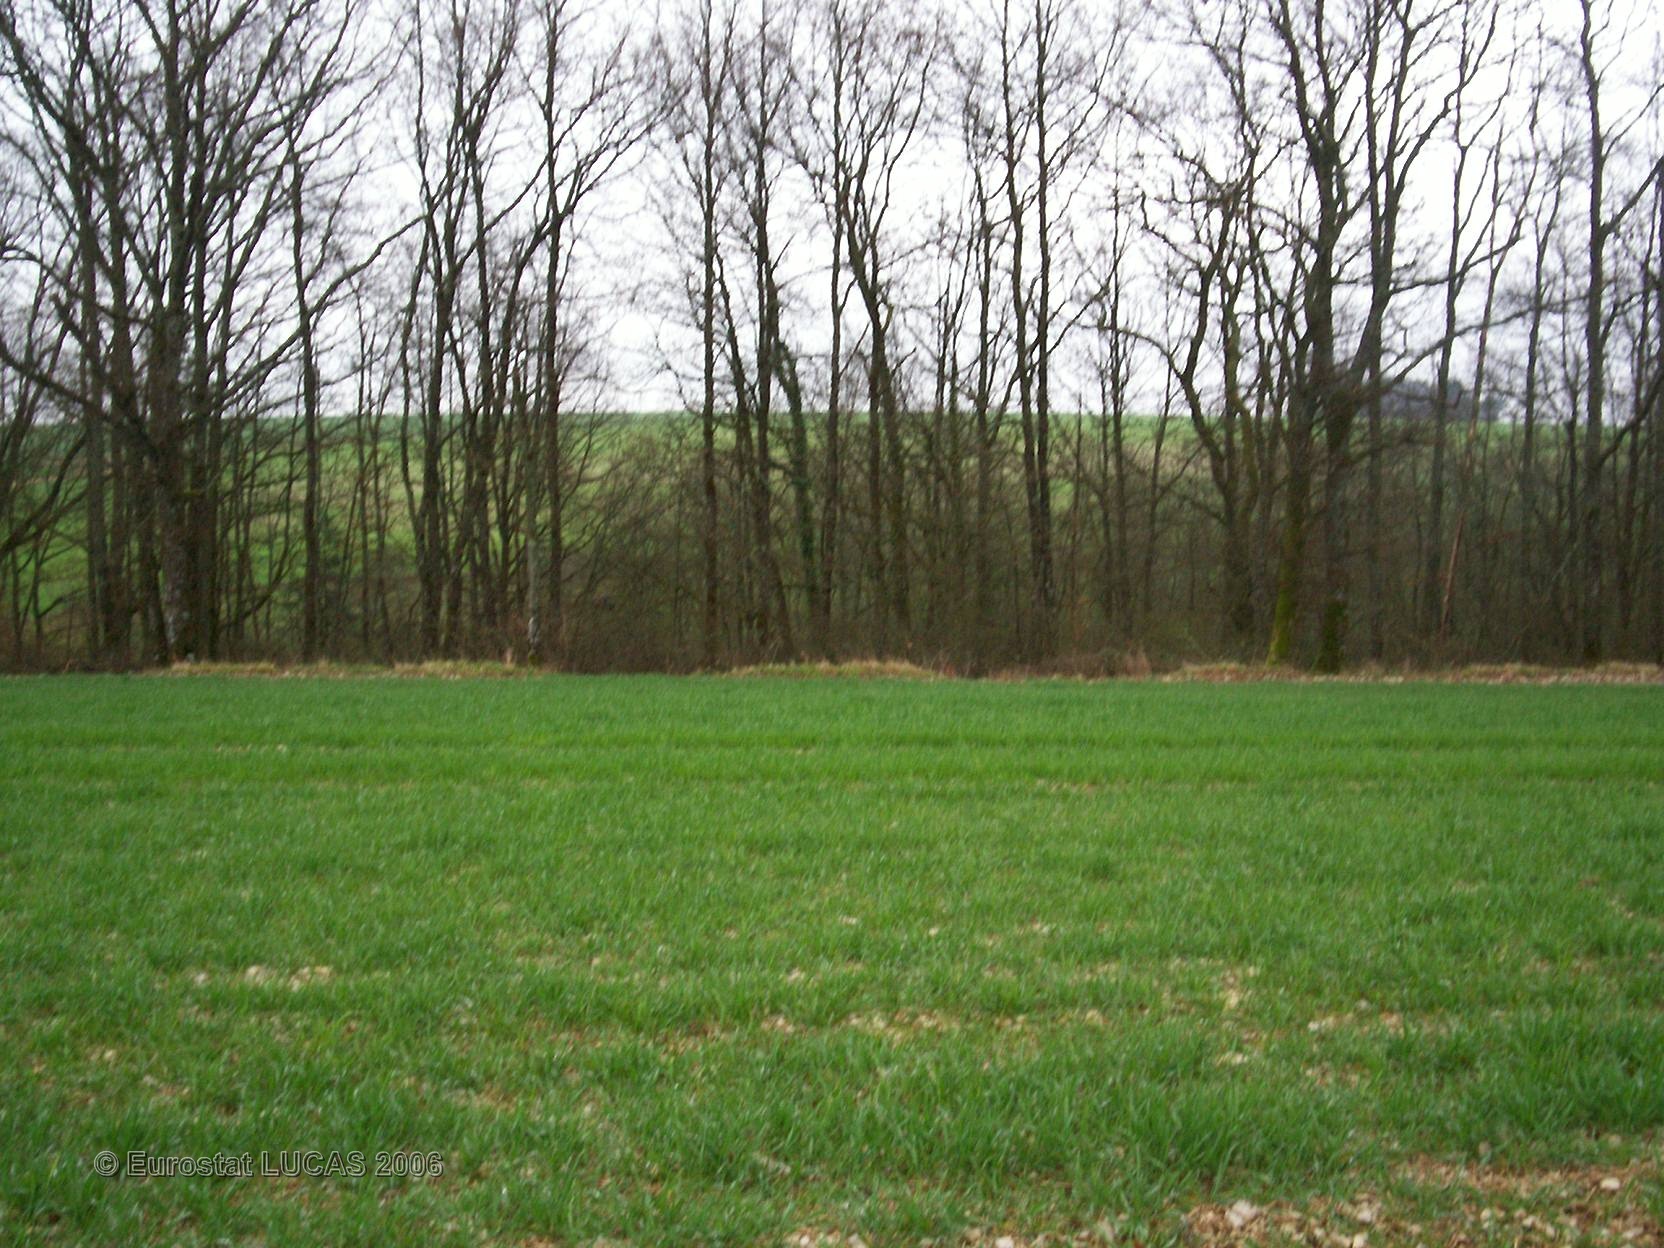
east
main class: Cropland
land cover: Common wheat
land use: Agriculture (excluding fallow land and kitchen gardens)
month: April
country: FR
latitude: 48.1032
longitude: 4.4784
